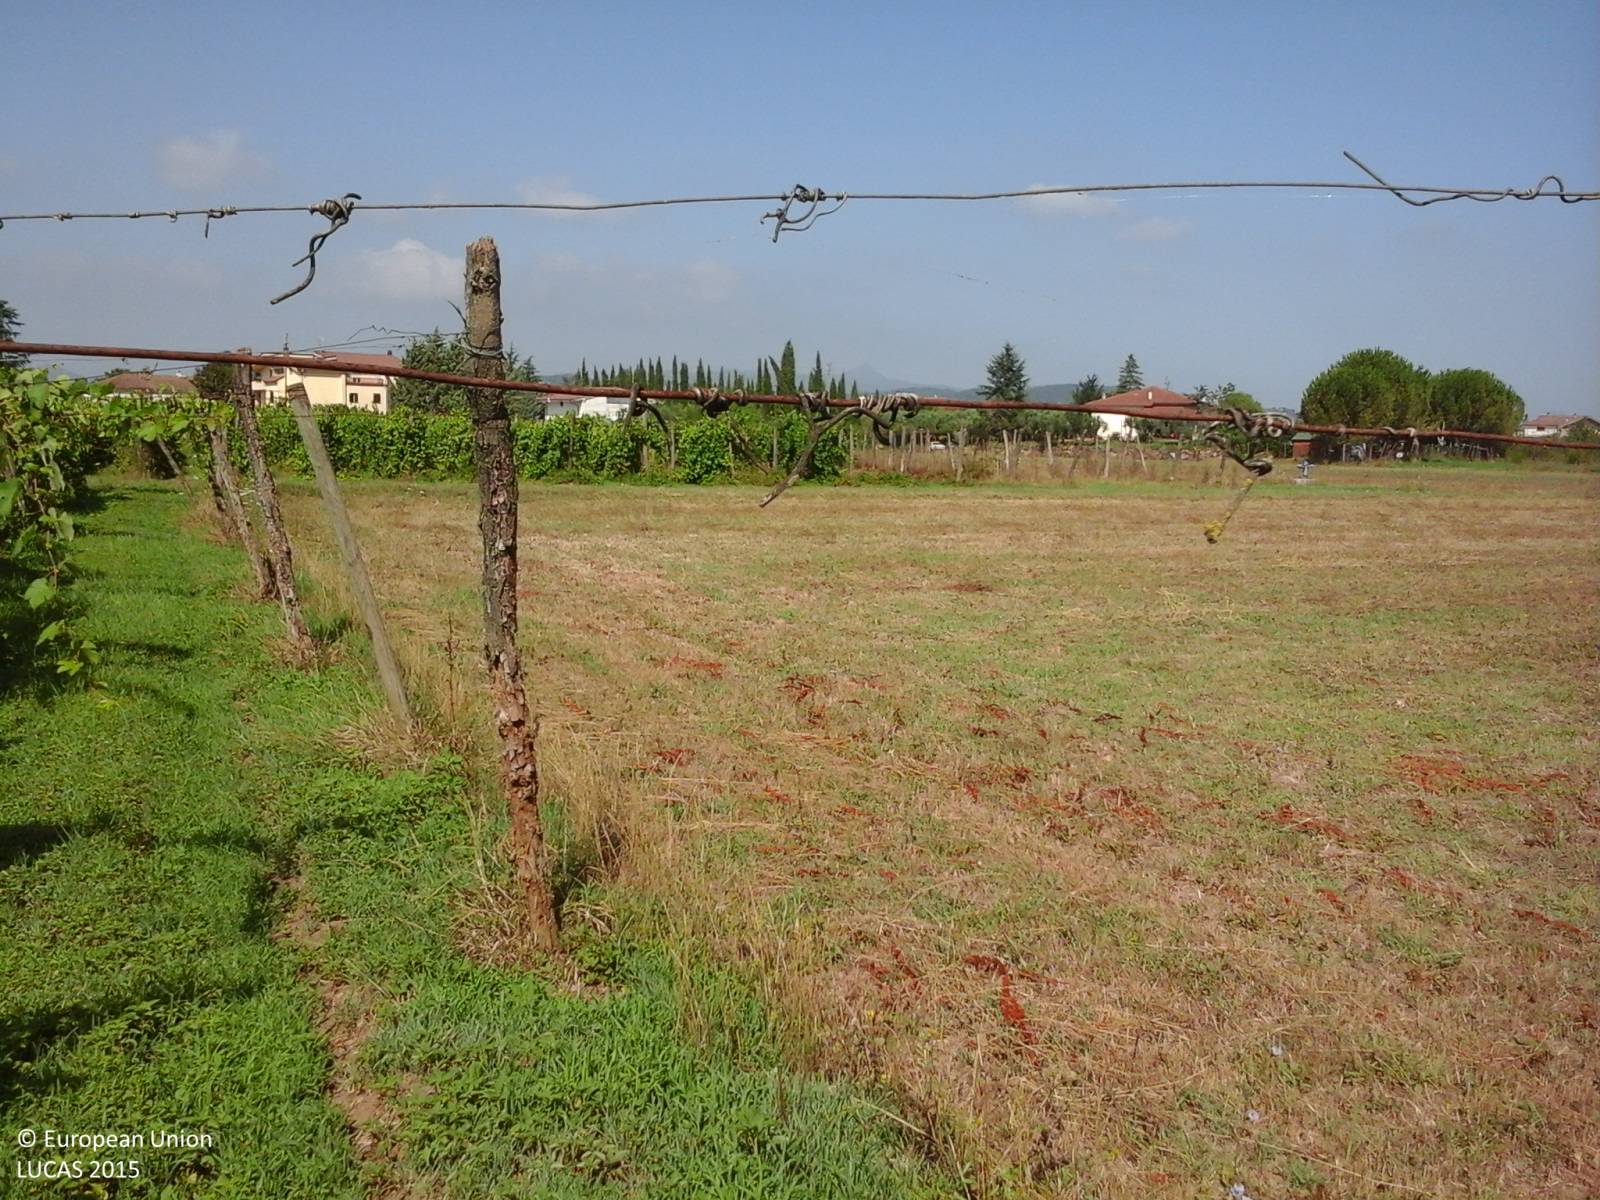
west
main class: Cropland
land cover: Vineyards
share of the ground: > 75 %
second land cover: Spontaneously vegetated surfaces
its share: > 75 %
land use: Agriculture (excluding fallow land and kitchen gardens)
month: July
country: IT
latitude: 41.2169
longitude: 14.4558
